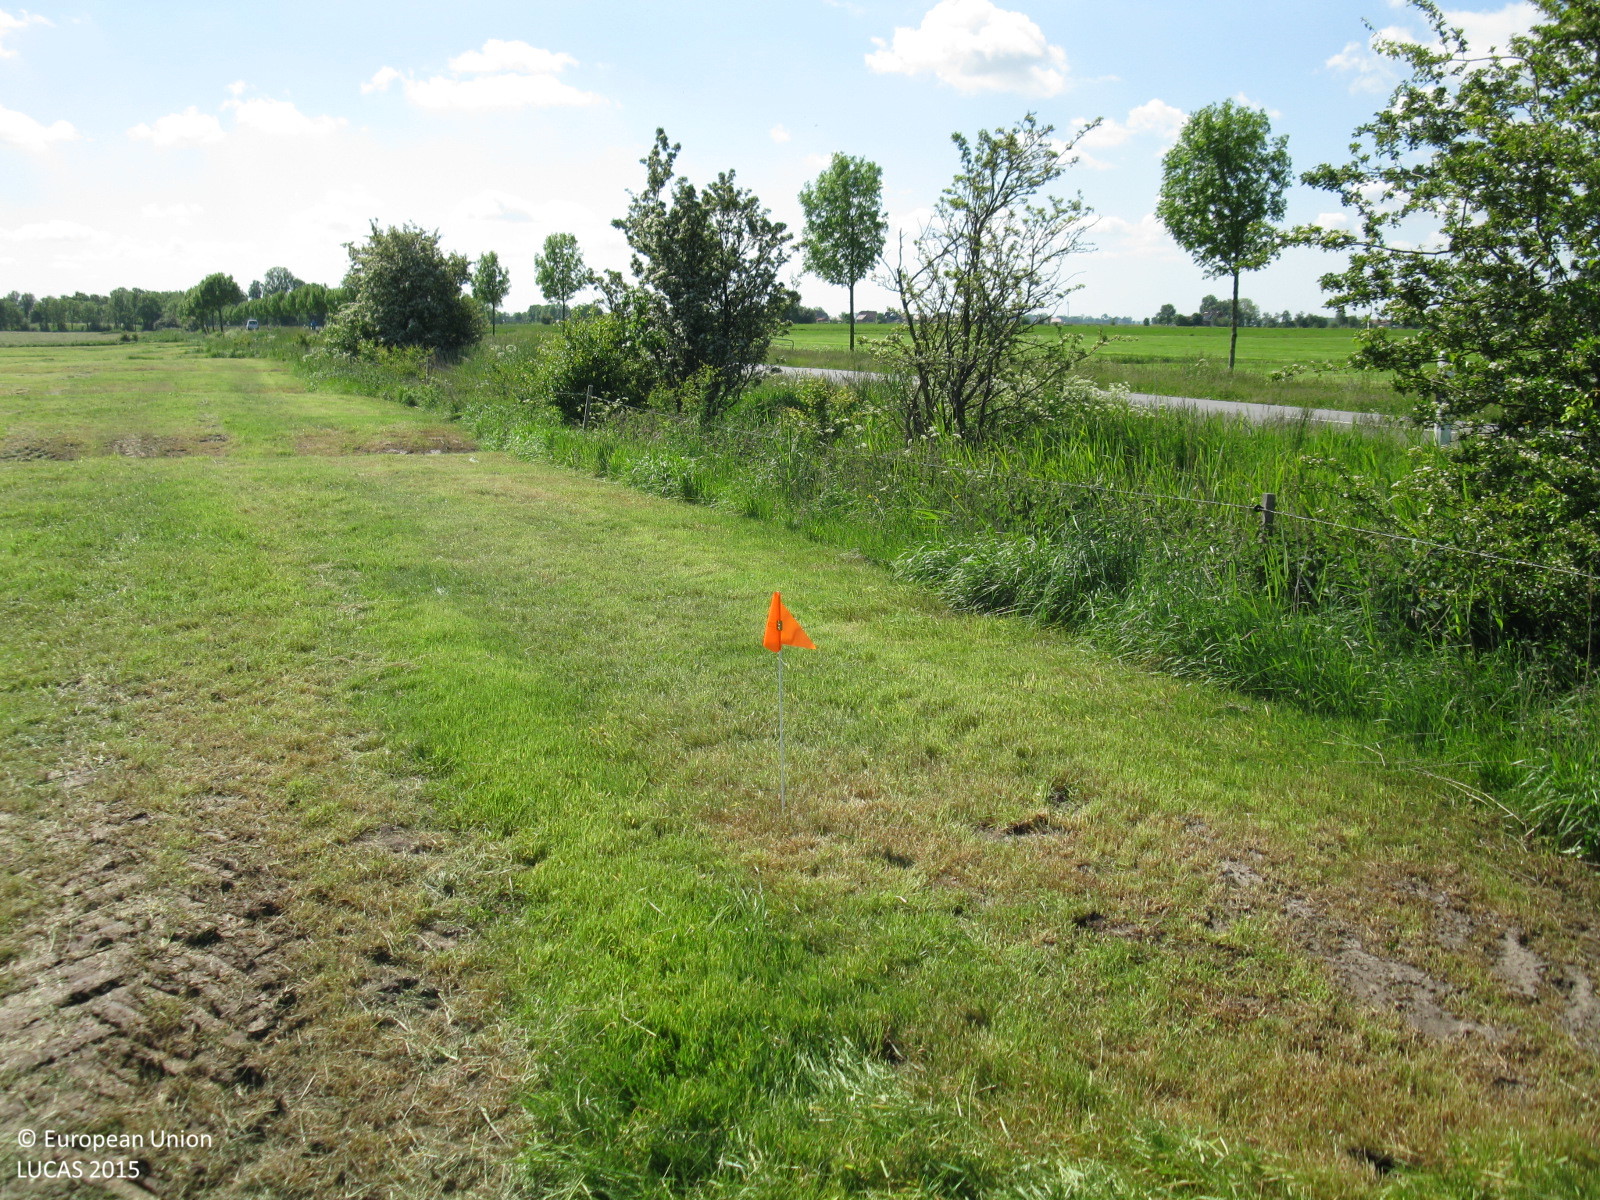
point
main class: Grassland
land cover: Grassland without tree/shrub cover
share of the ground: > 75 %
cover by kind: herbaceous plants 100 %
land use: Agriculture (excluding fallow land and kitchen gardens)
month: June
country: DE
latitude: 53.3009
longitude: 7.3447
